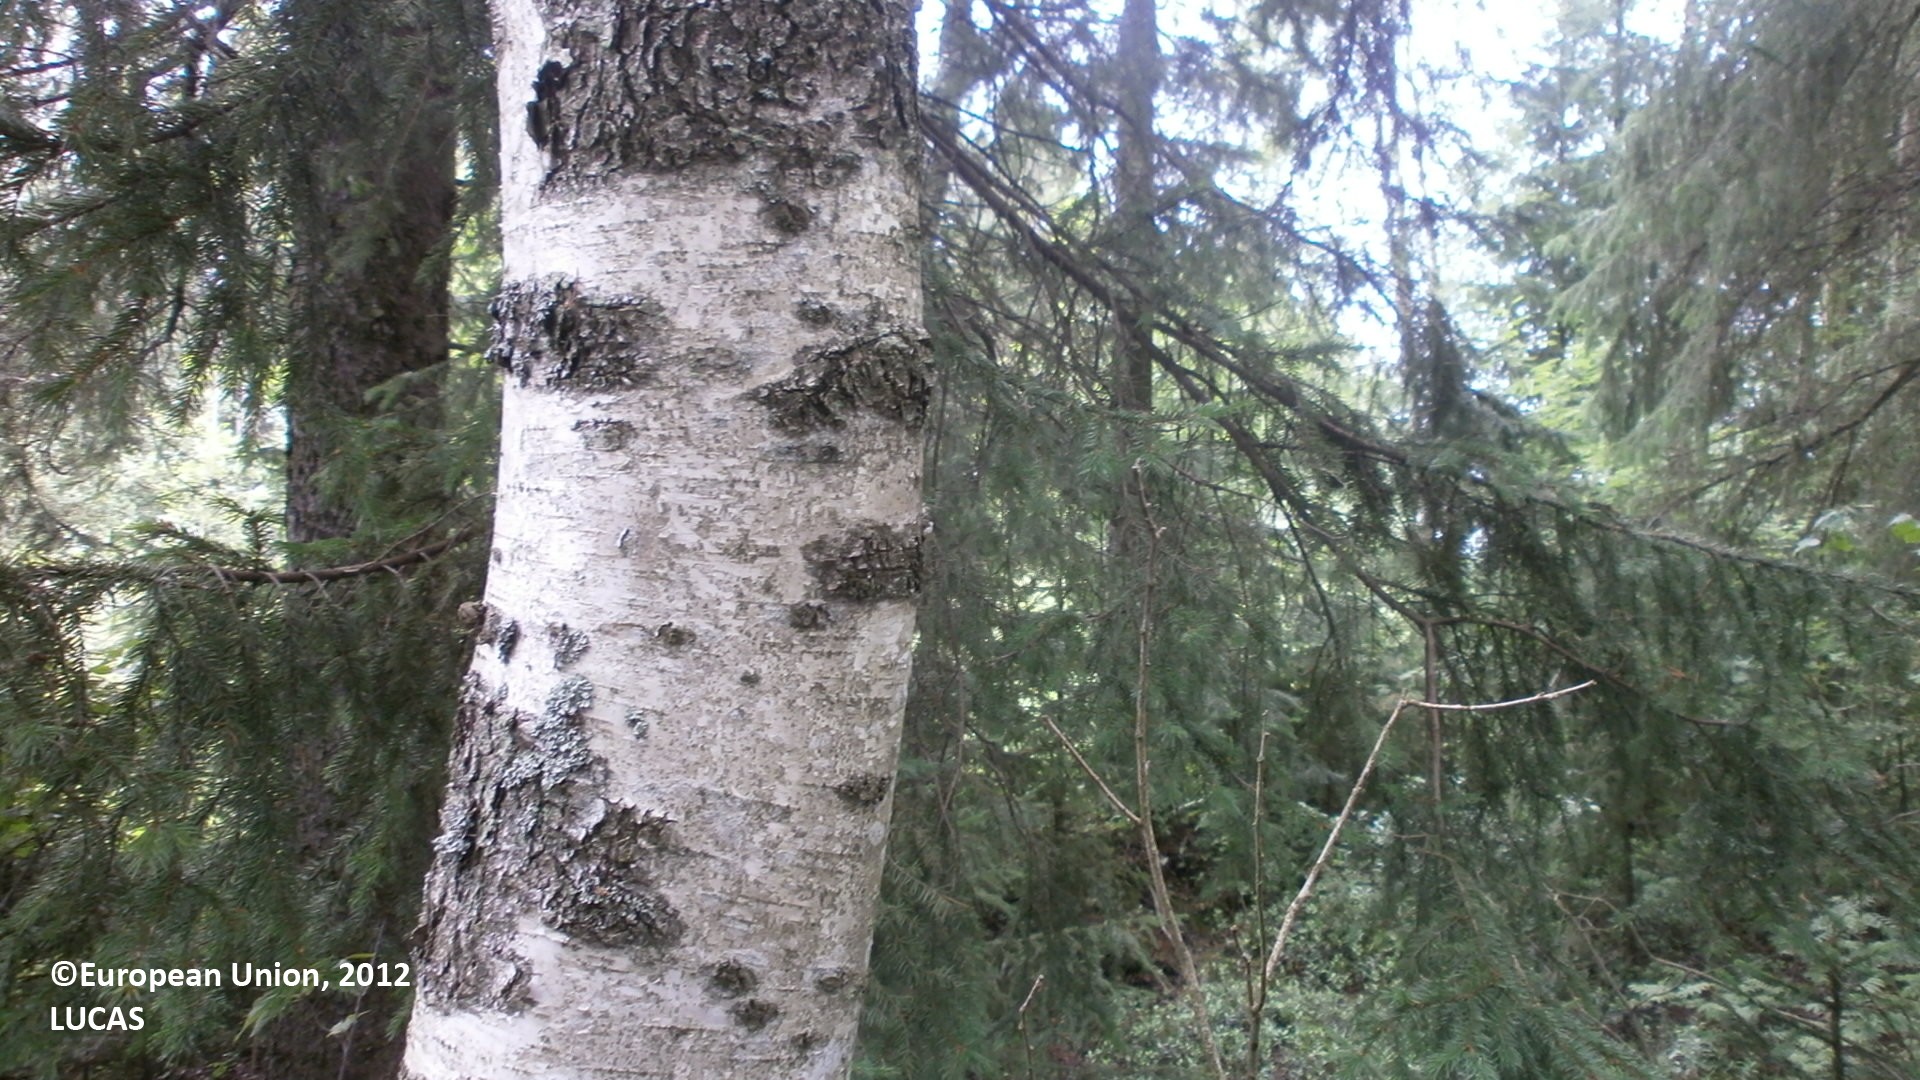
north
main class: Woodland
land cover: Spruce dominated mixed woodland
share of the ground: > 75 %
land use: Forestry
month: July
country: FI
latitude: 64.7794
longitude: 24.6878
